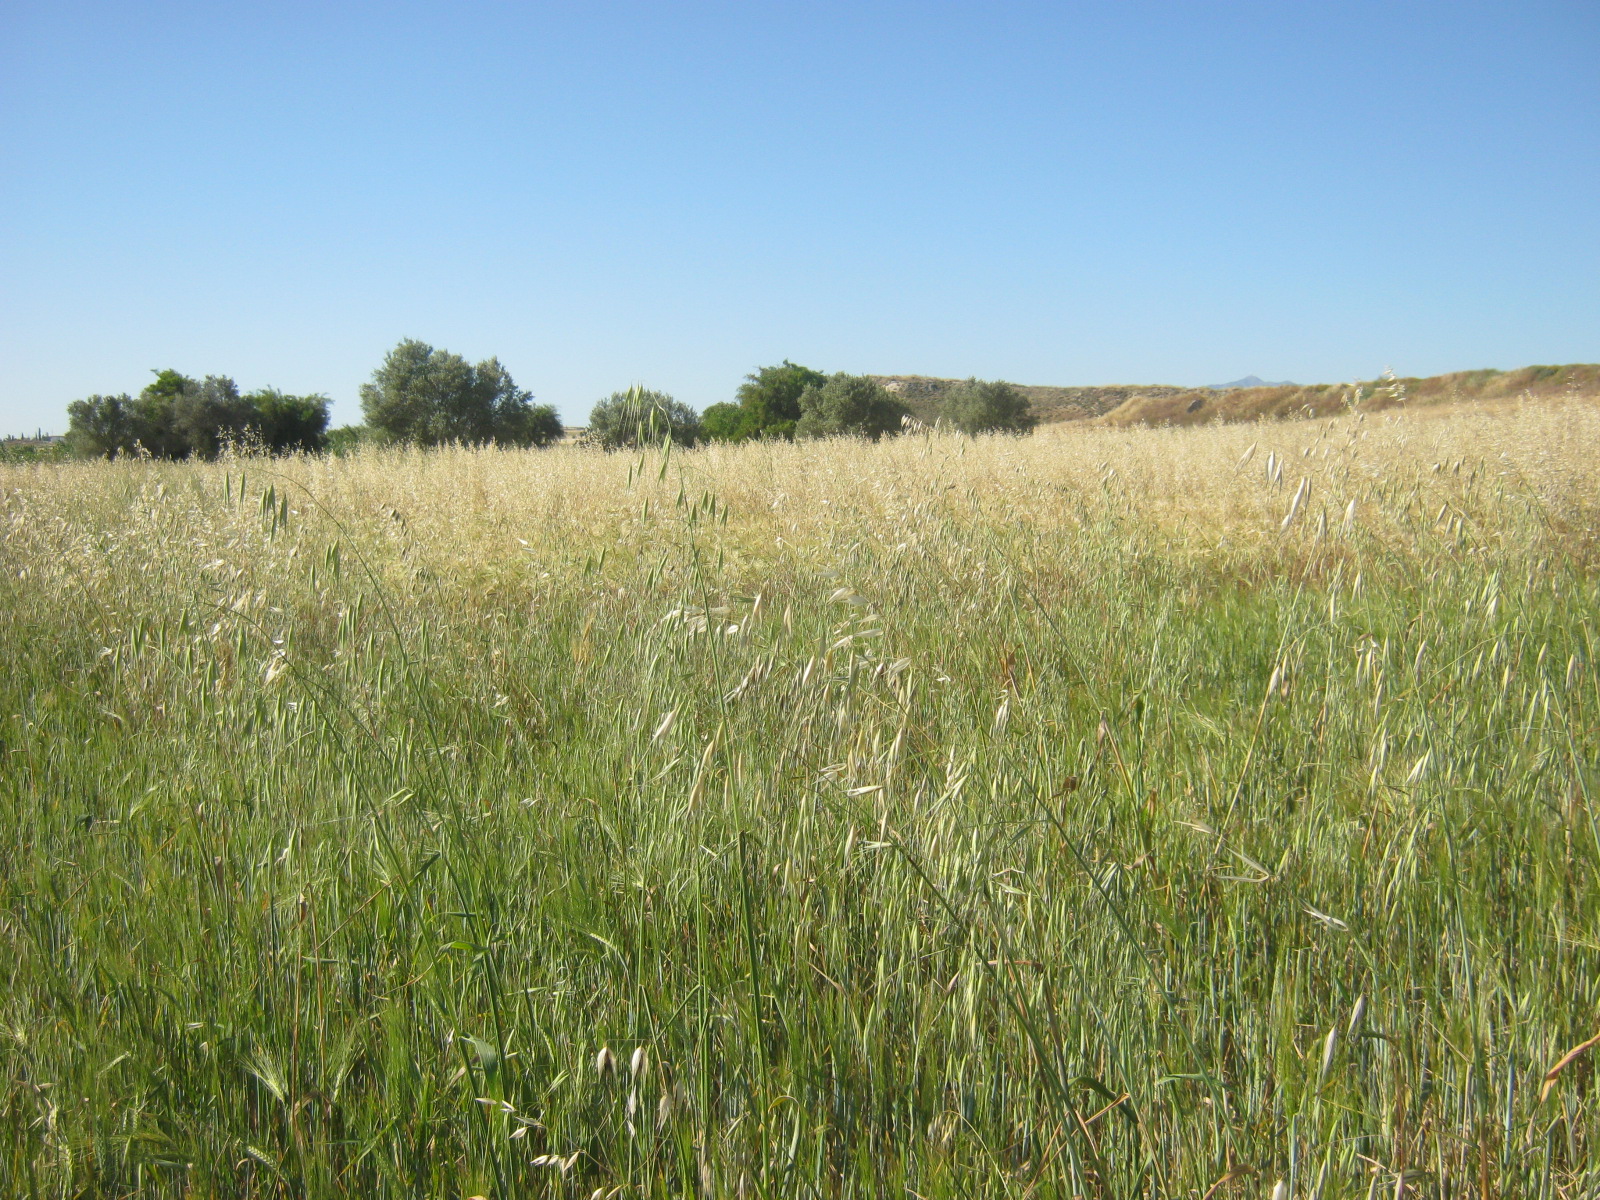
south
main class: Cropland
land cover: Common wheat
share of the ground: > 75 %
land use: Agriculture (excluding fallow land and kitchen gardens)
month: May
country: CY
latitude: 35.1428
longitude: 33.2488
